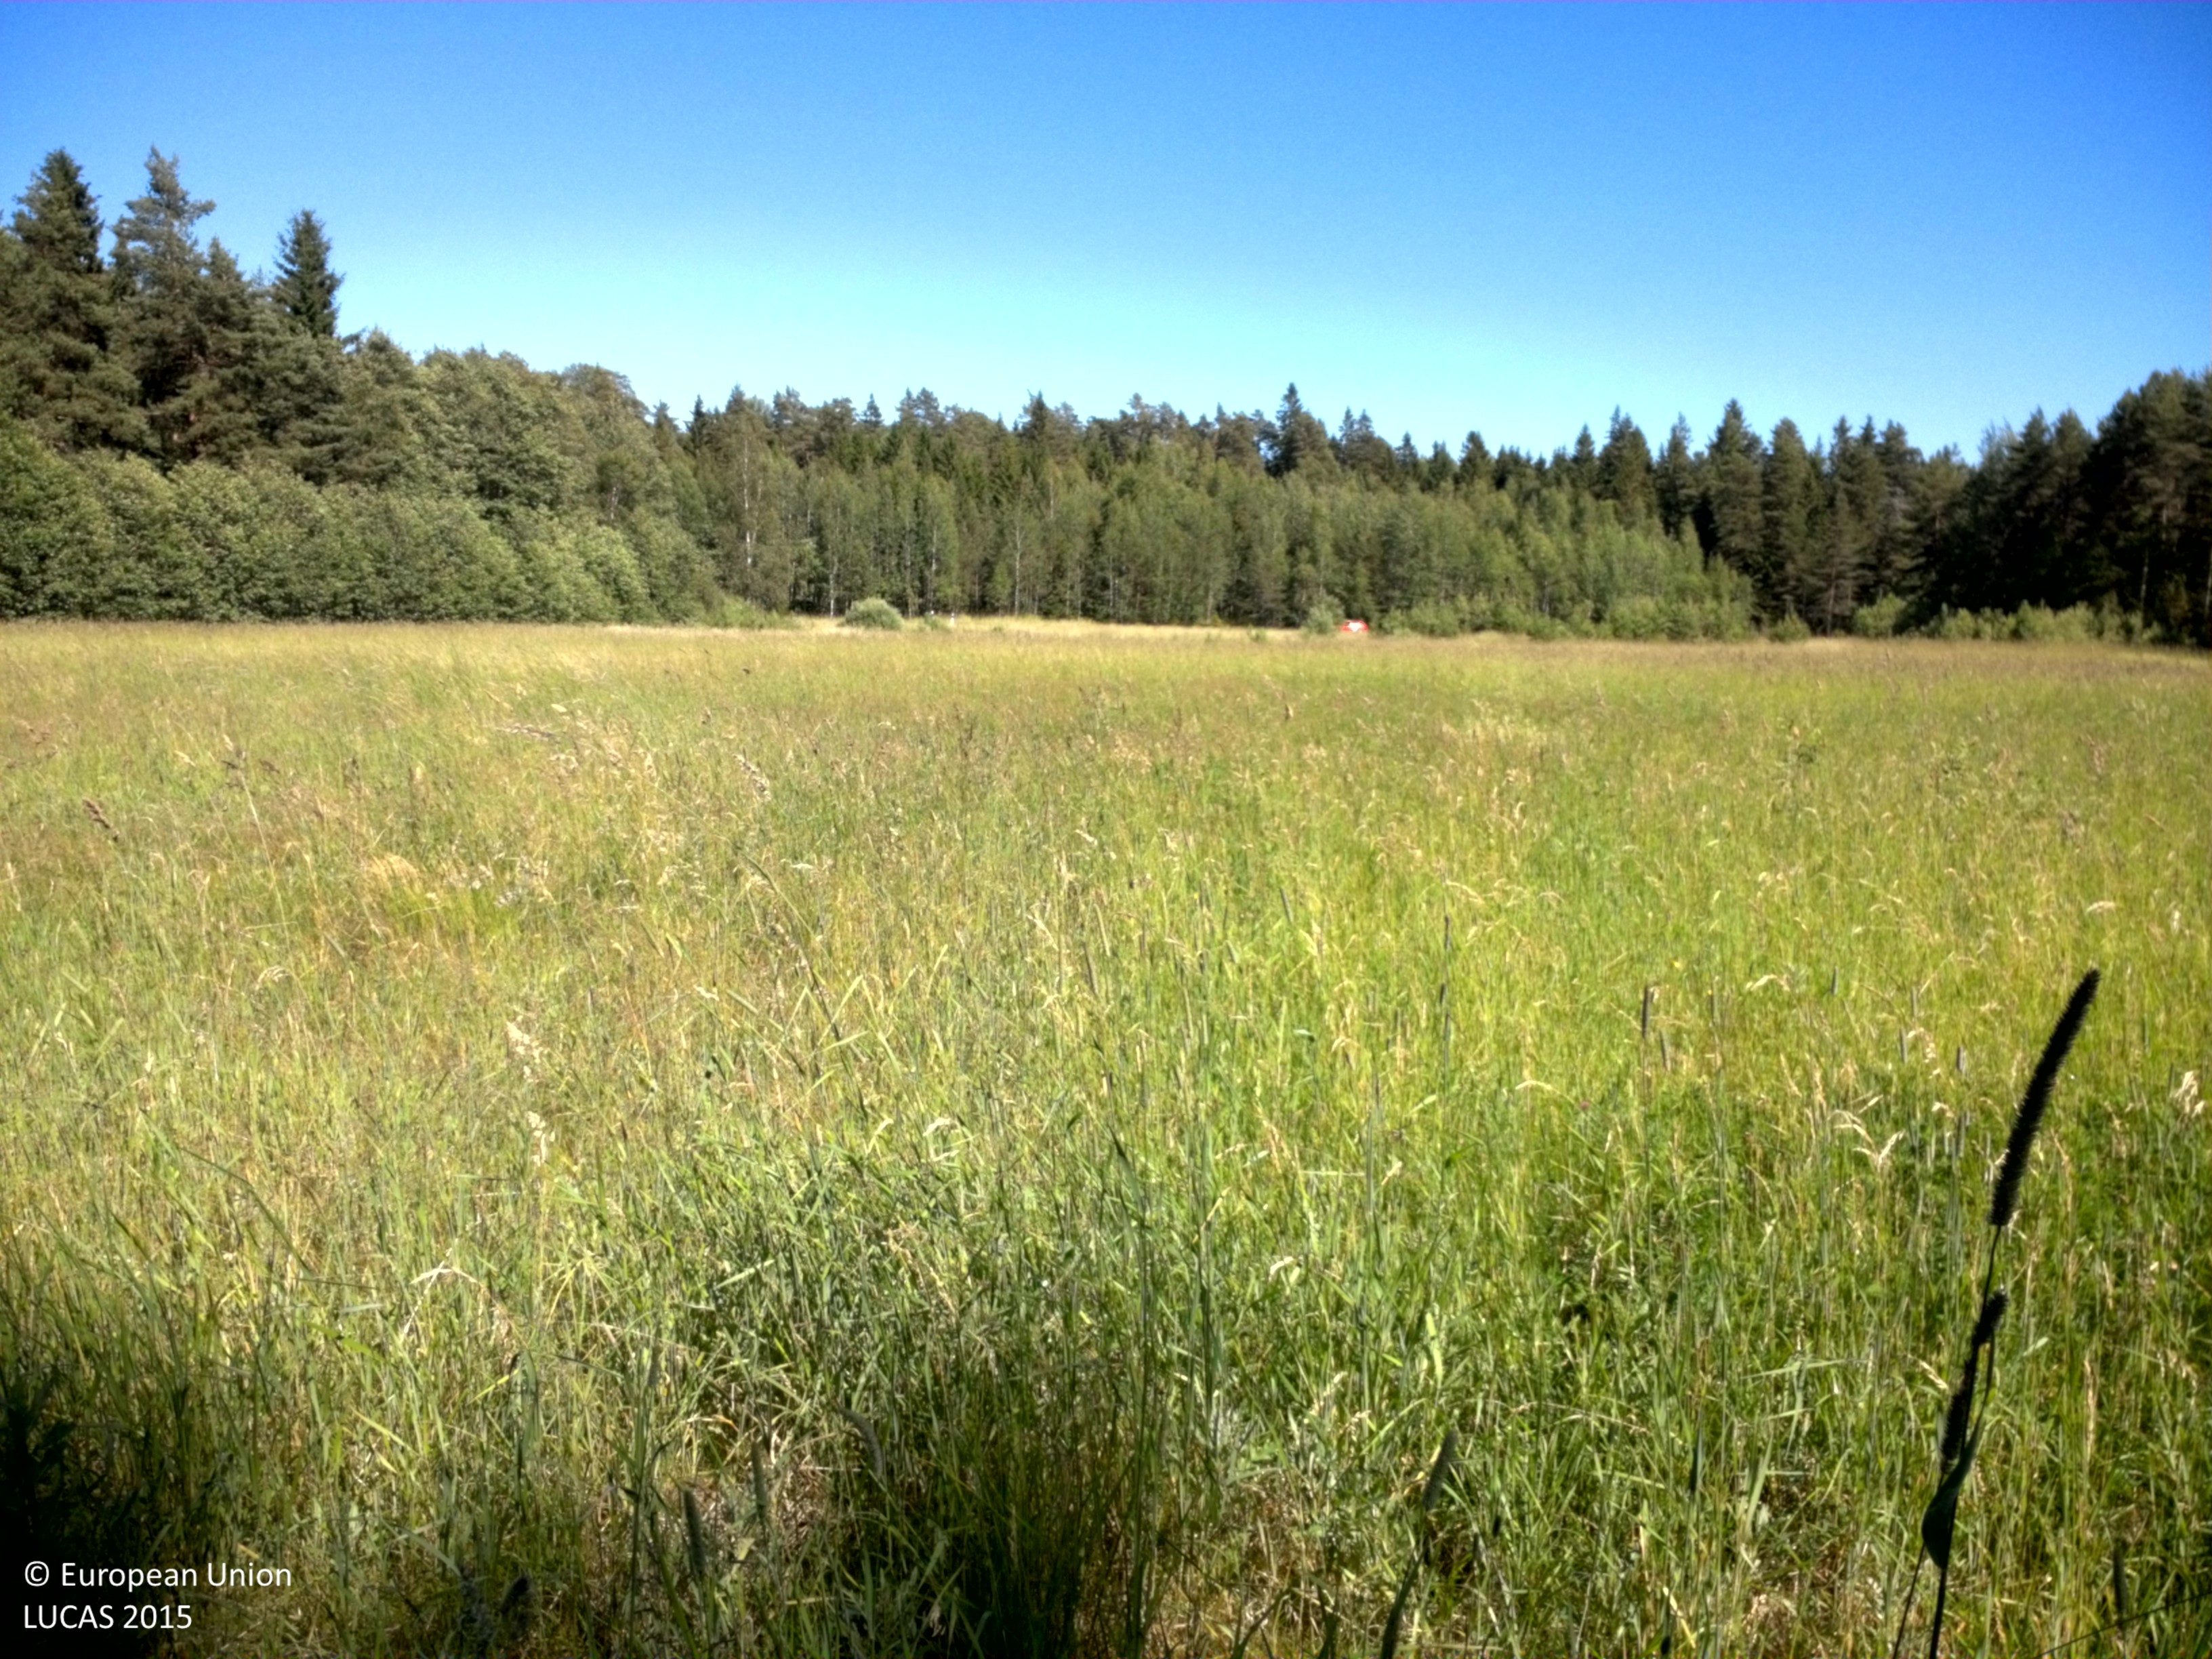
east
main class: Grassland
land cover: Grassland without tree/shrub cover
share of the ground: > 75 %
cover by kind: herbaceous plants 100 %
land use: Agriculture (excluding fallow land and kitchen gardens)
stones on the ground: < 10 %
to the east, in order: Grassland without tree/shrub cover; Ditches and canals; Grass margins; Paved roads, cycling and walking lanes; Grassland without tree/shrub cover; Tracks; Grass margins; Ditches and canals; Spruce dominated mixed woodland; Tracks; Spruce dominated coniferous woodland
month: July
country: SE
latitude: 59.7143
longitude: 18.3714
